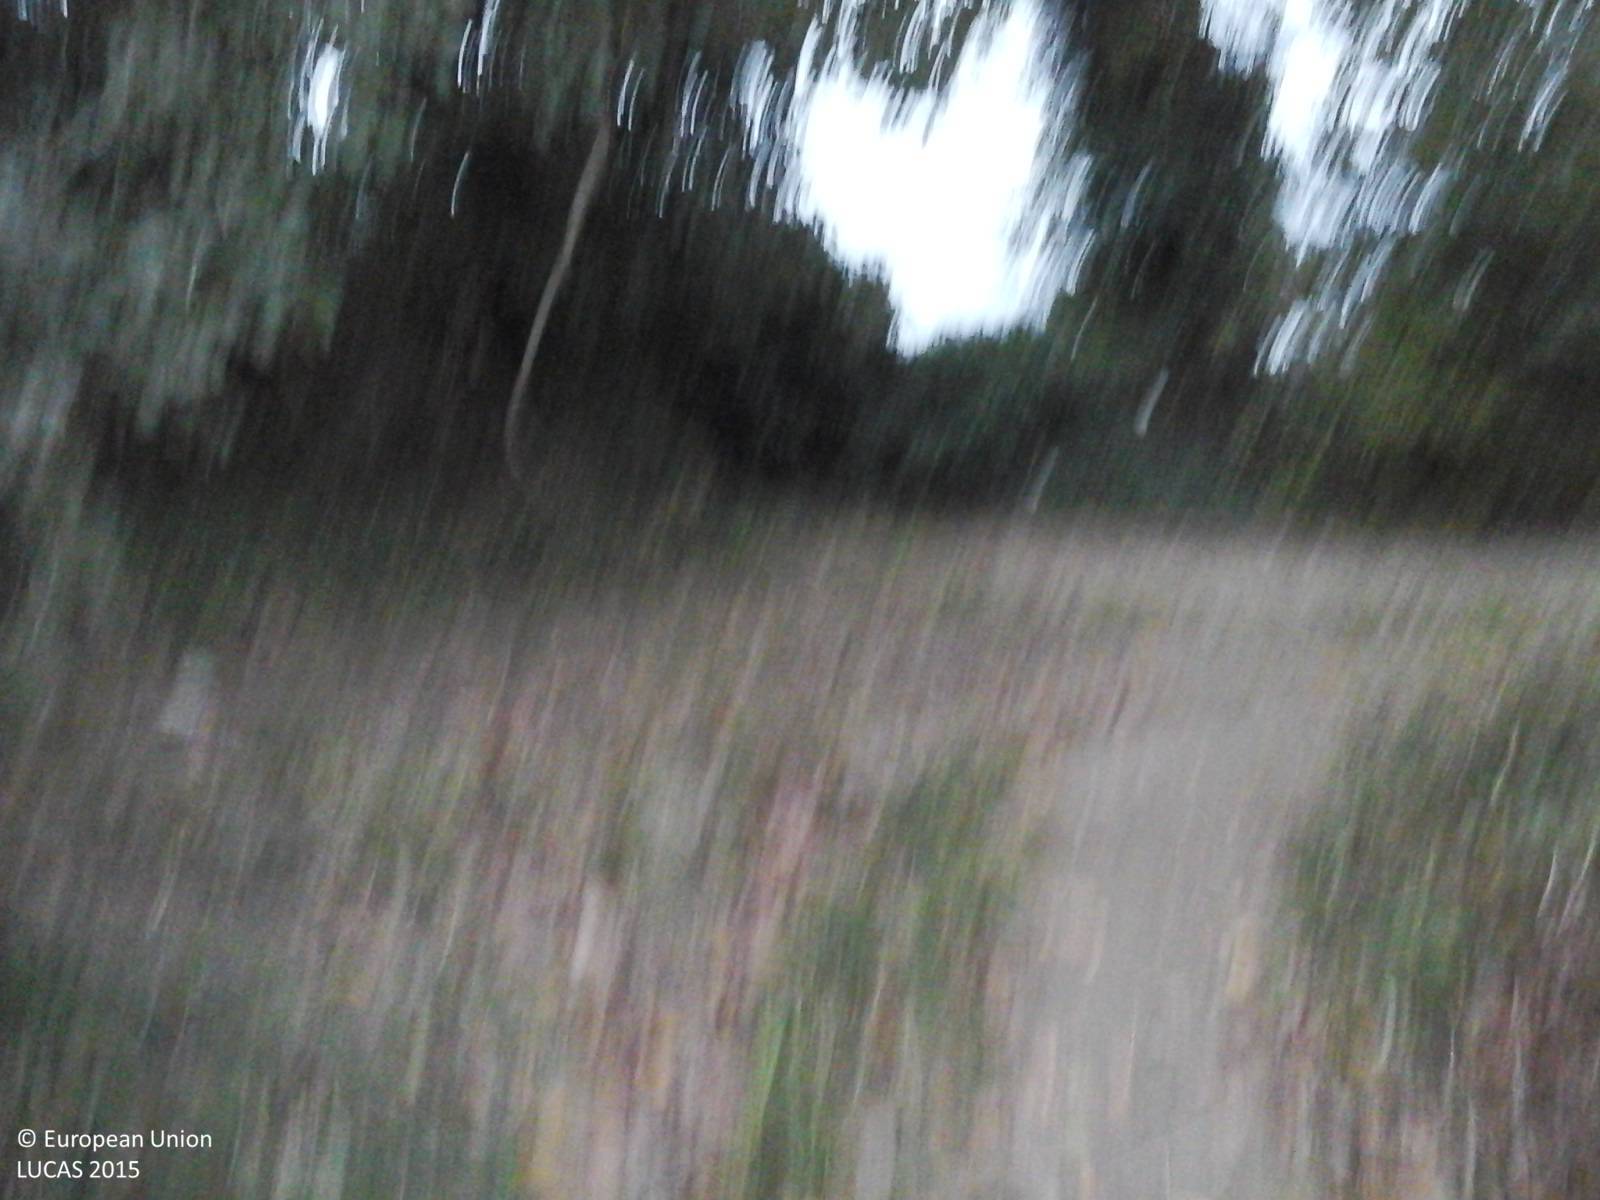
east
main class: Woodland
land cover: Broadleaved woodland
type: floodplain forest
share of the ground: > 75 %
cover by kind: broadleaved forest trees 95 %, shrubs 5 %
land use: Abandoned areas
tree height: > 5 m
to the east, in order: Broadleaved woodland; Inland fresh running water; Broadleaved woodland; Other bare soil
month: October
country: IT
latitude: 42.6291
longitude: 12.2485
